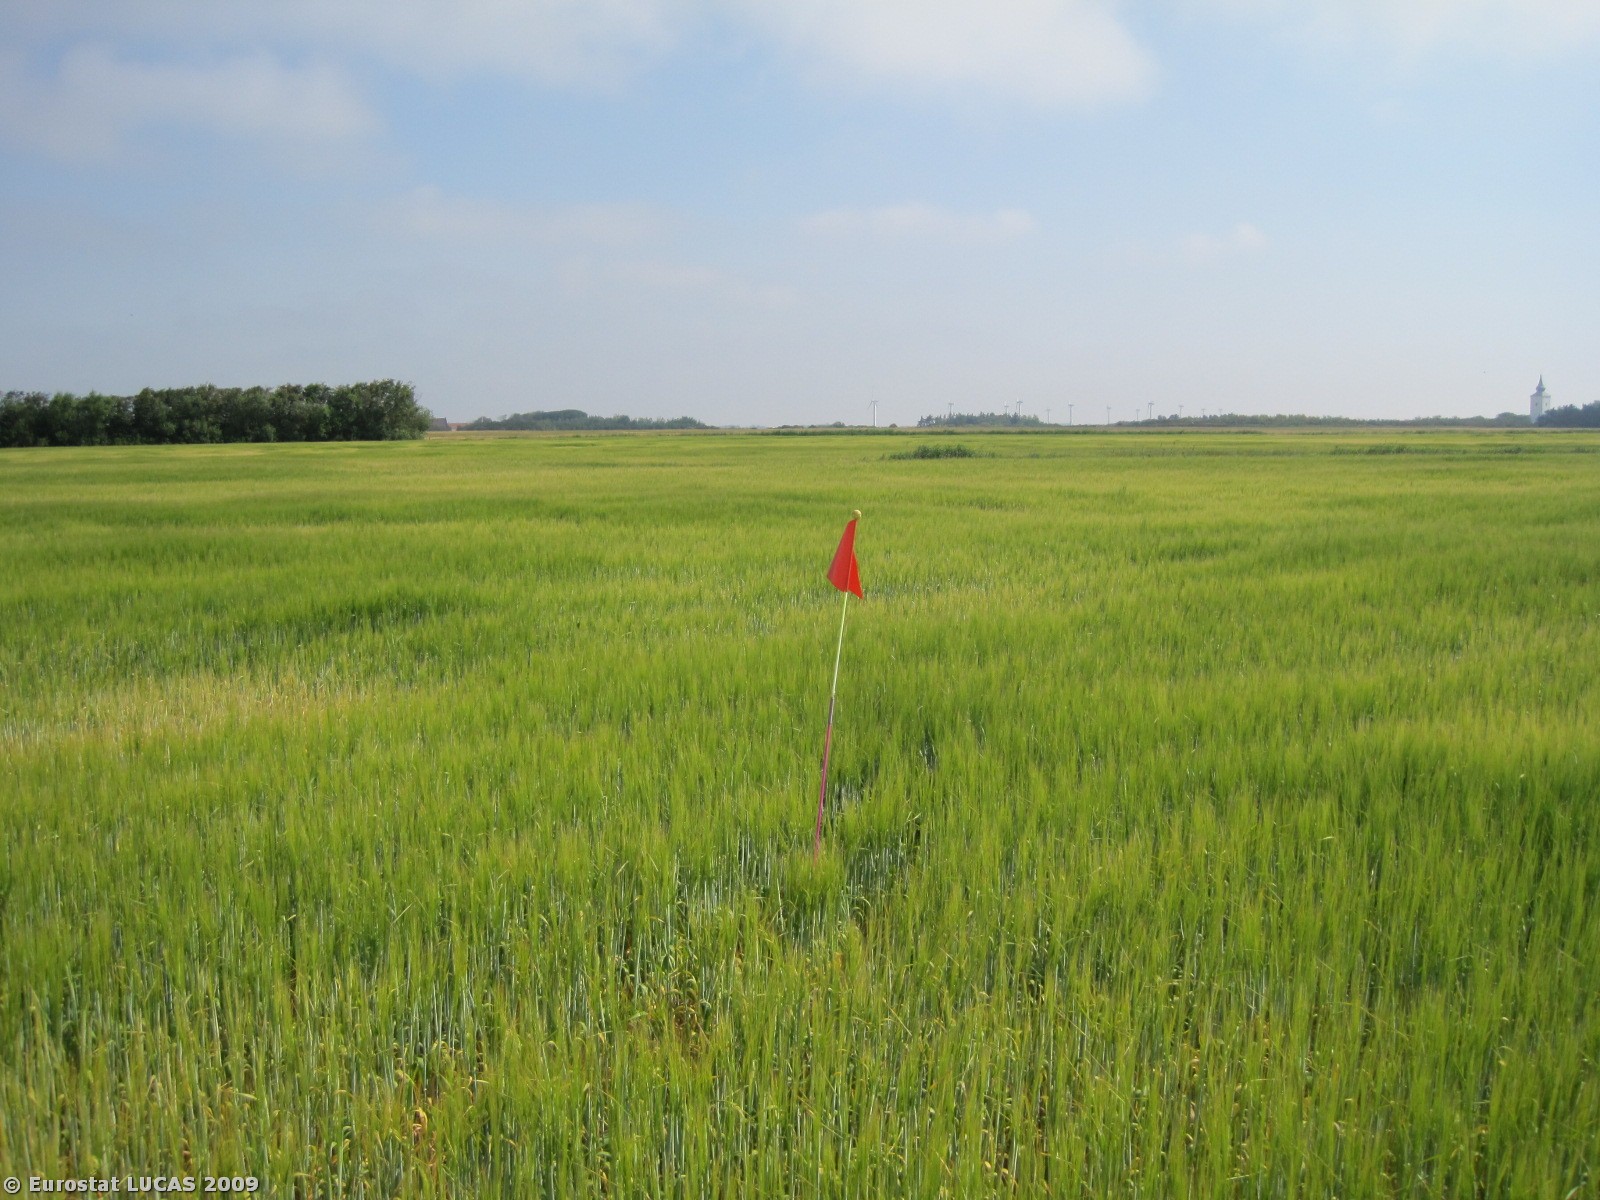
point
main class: Cropland
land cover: Barley
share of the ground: > 75 %
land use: Agriculture (excluding fallow land and kitchen gardens)
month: July
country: DK
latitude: 56.4444
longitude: 8.1691
